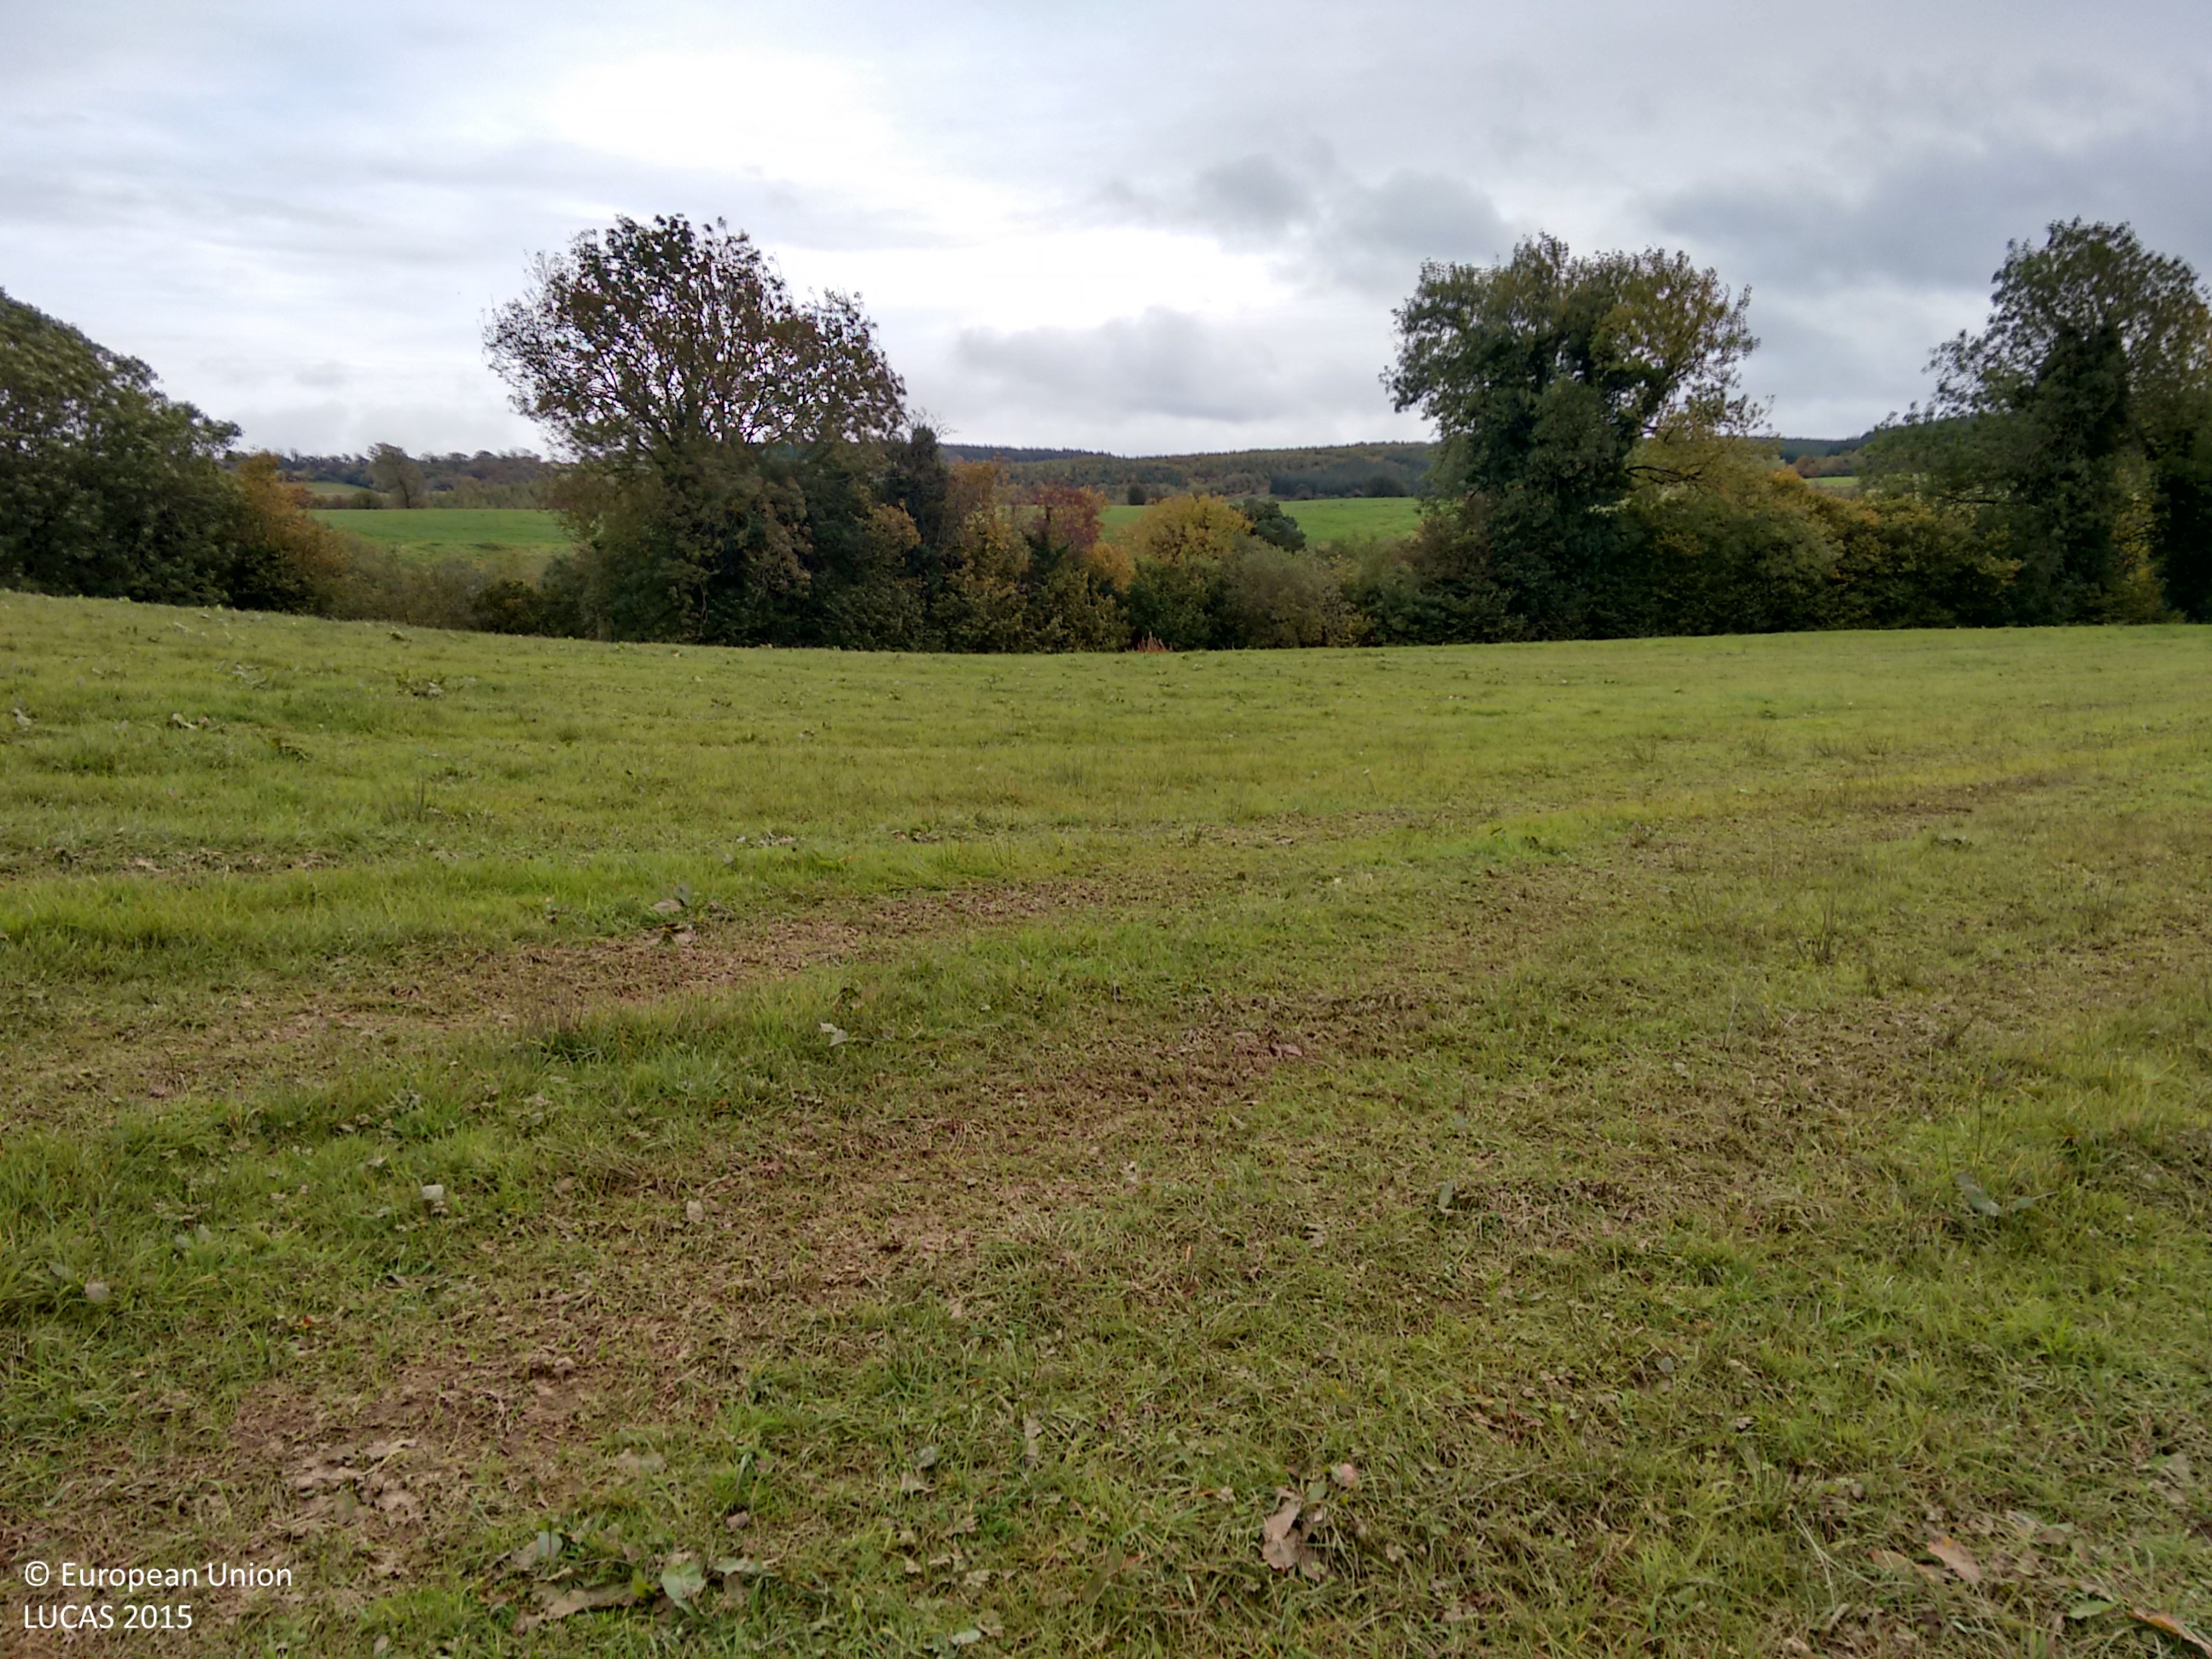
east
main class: Grassland
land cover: Grassland without tree/shrub cover
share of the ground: > 75 %
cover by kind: herbaceous plants 100 %
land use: Agriculture (excluding fallow land and kitchen gardens)
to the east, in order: Grassland without tree/shrub cover; Abandoned hedges; Grassland without tree/shrub cover; Inland fresh running water; Abandoned hedges; Fences; Grassland without tree/shrub cover
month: October
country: GB
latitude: 54.3008
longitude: -7.4101
